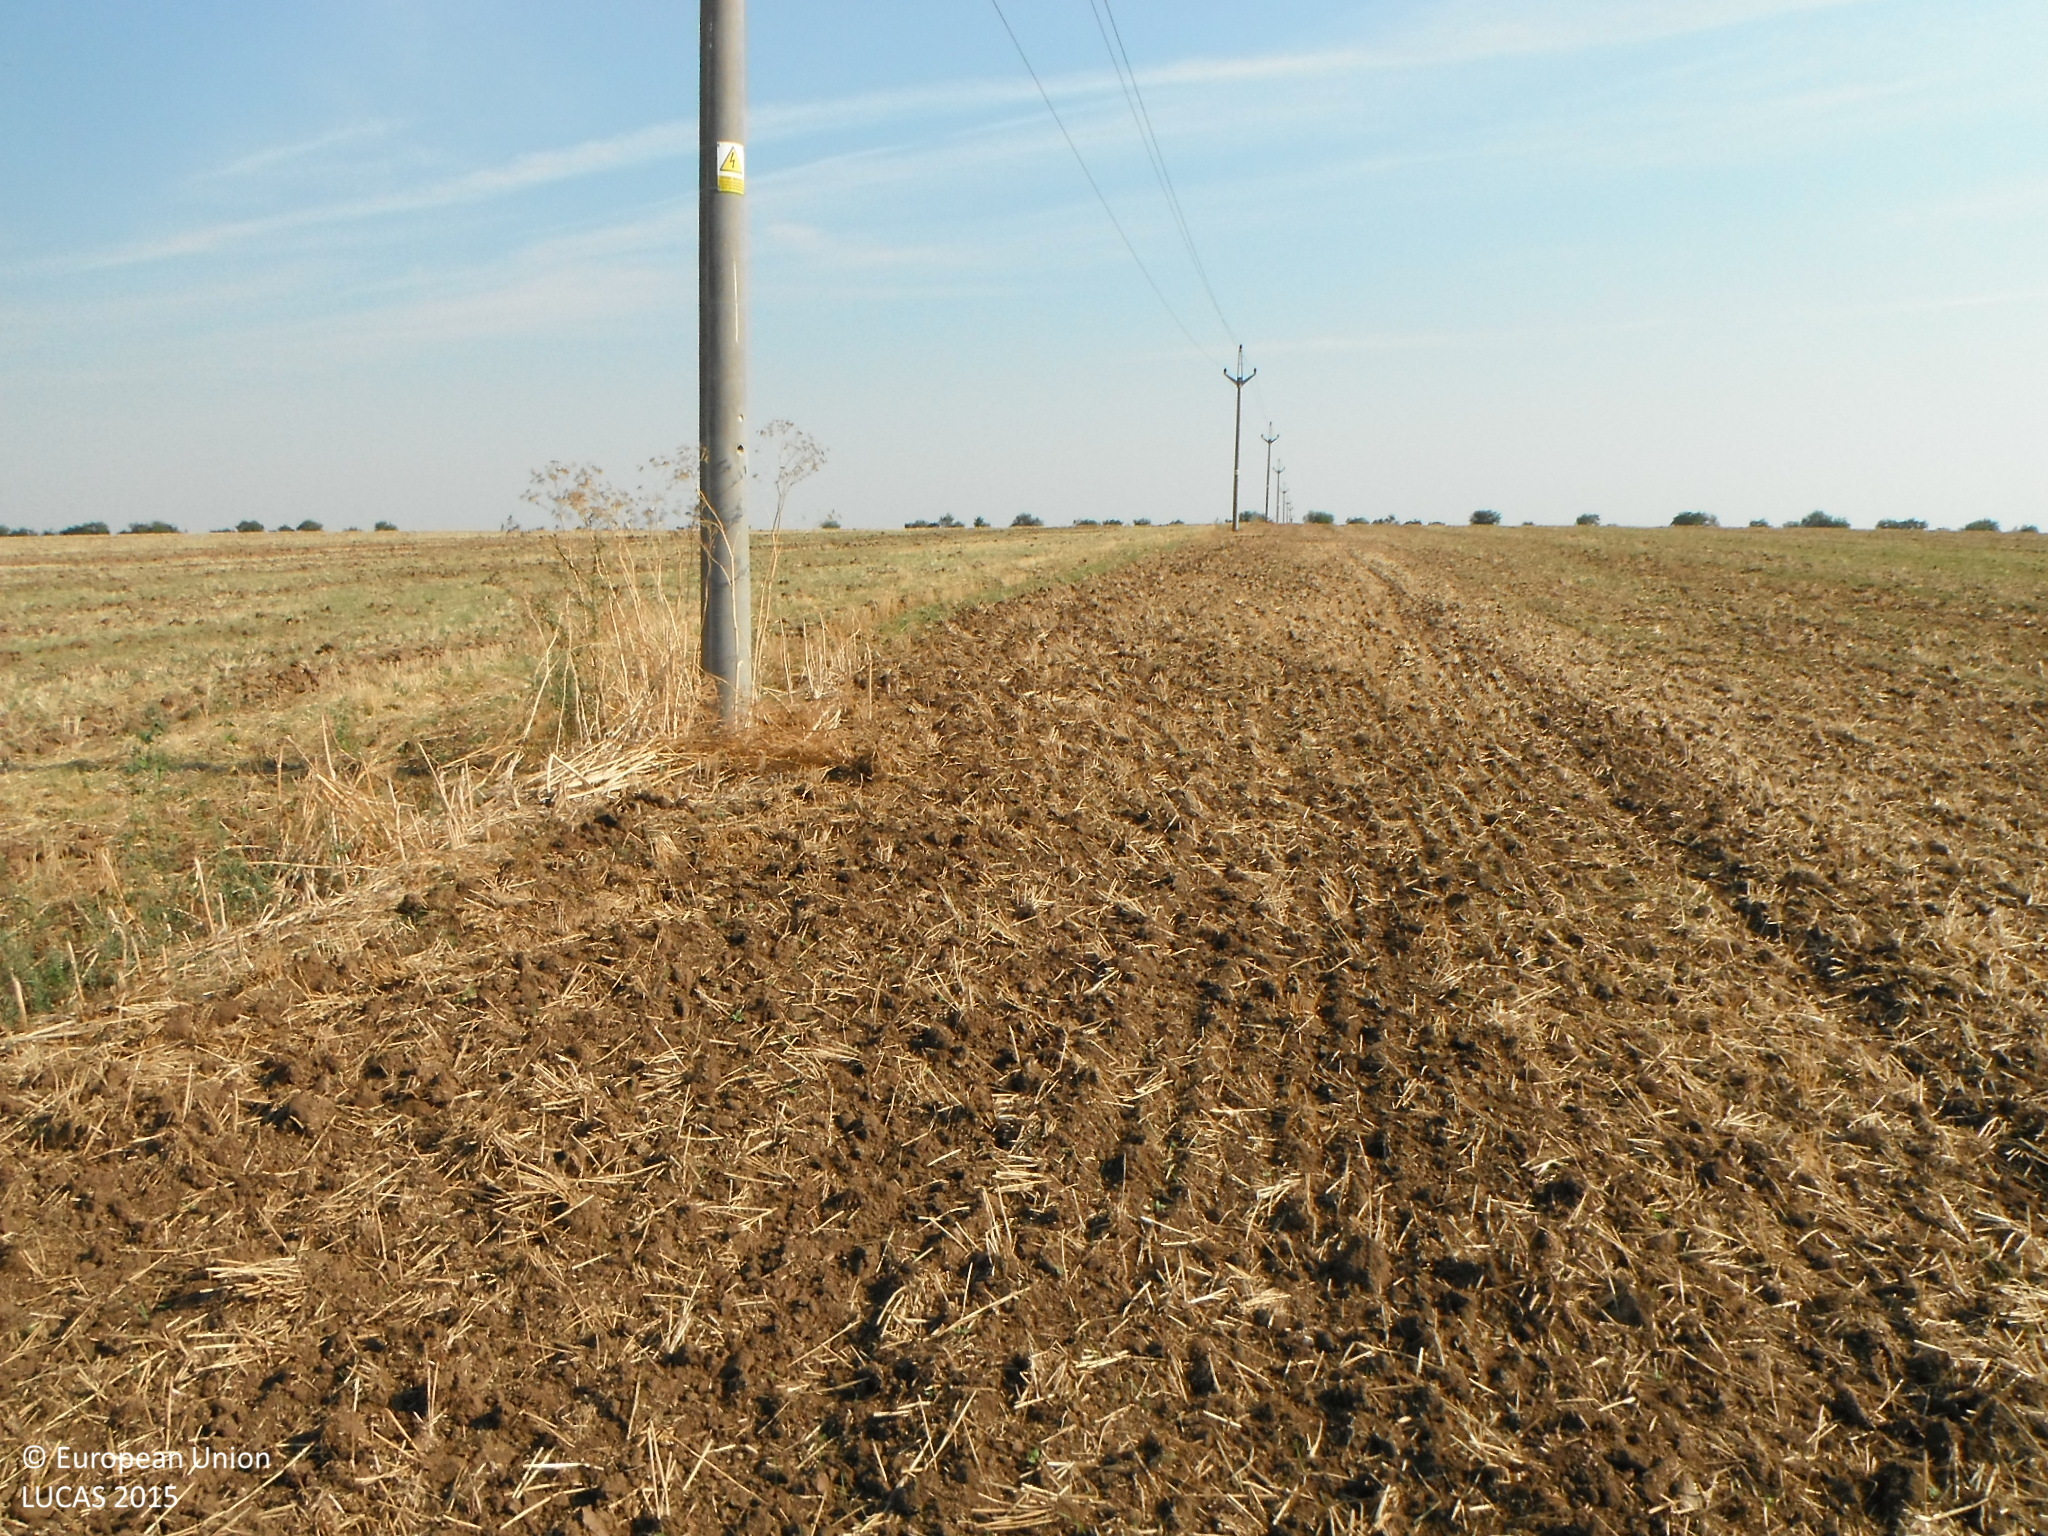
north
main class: Cropland
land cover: Common wheat
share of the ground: < 10 %
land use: Agriculture (excluding fallow land and kitchen gardens)
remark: Harvested field
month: August
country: SK
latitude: 47.9236
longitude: 18.5944
